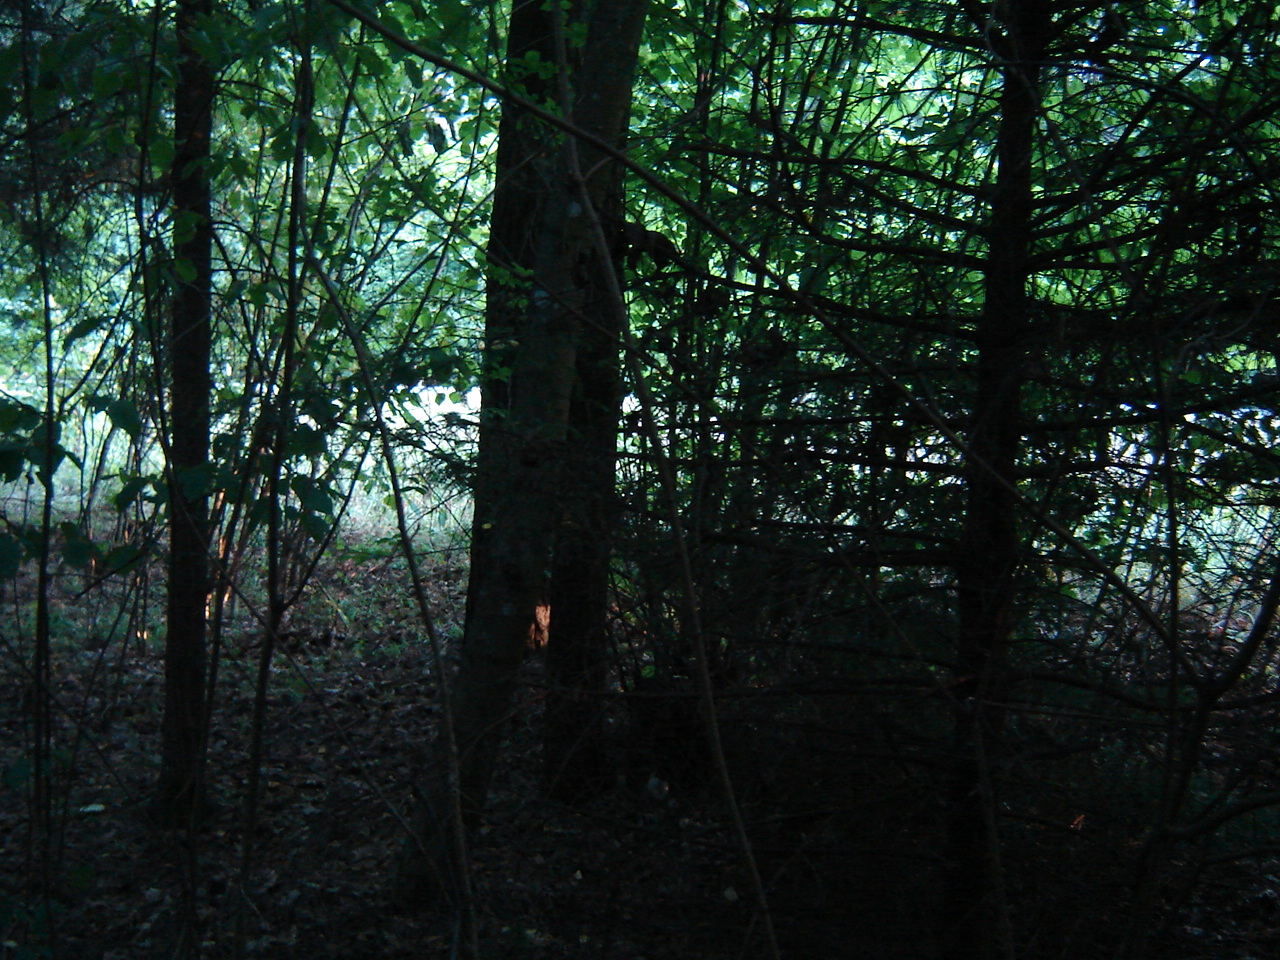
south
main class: Woodland
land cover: Spruce dominated mixed woodland
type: hemiboreal forest and nemoral coniferous forest and mixed broadleaved-coniferous forest
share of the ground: > 75 %
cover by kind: coniferous forest trees 65 %, broadleaved forest trees 30 %, unconsolidated bare surface 5 %
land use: Forestry
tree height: > 5 m
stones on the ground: < 10 %
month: August
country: LT
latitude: 54.8038
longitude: 25.0022
